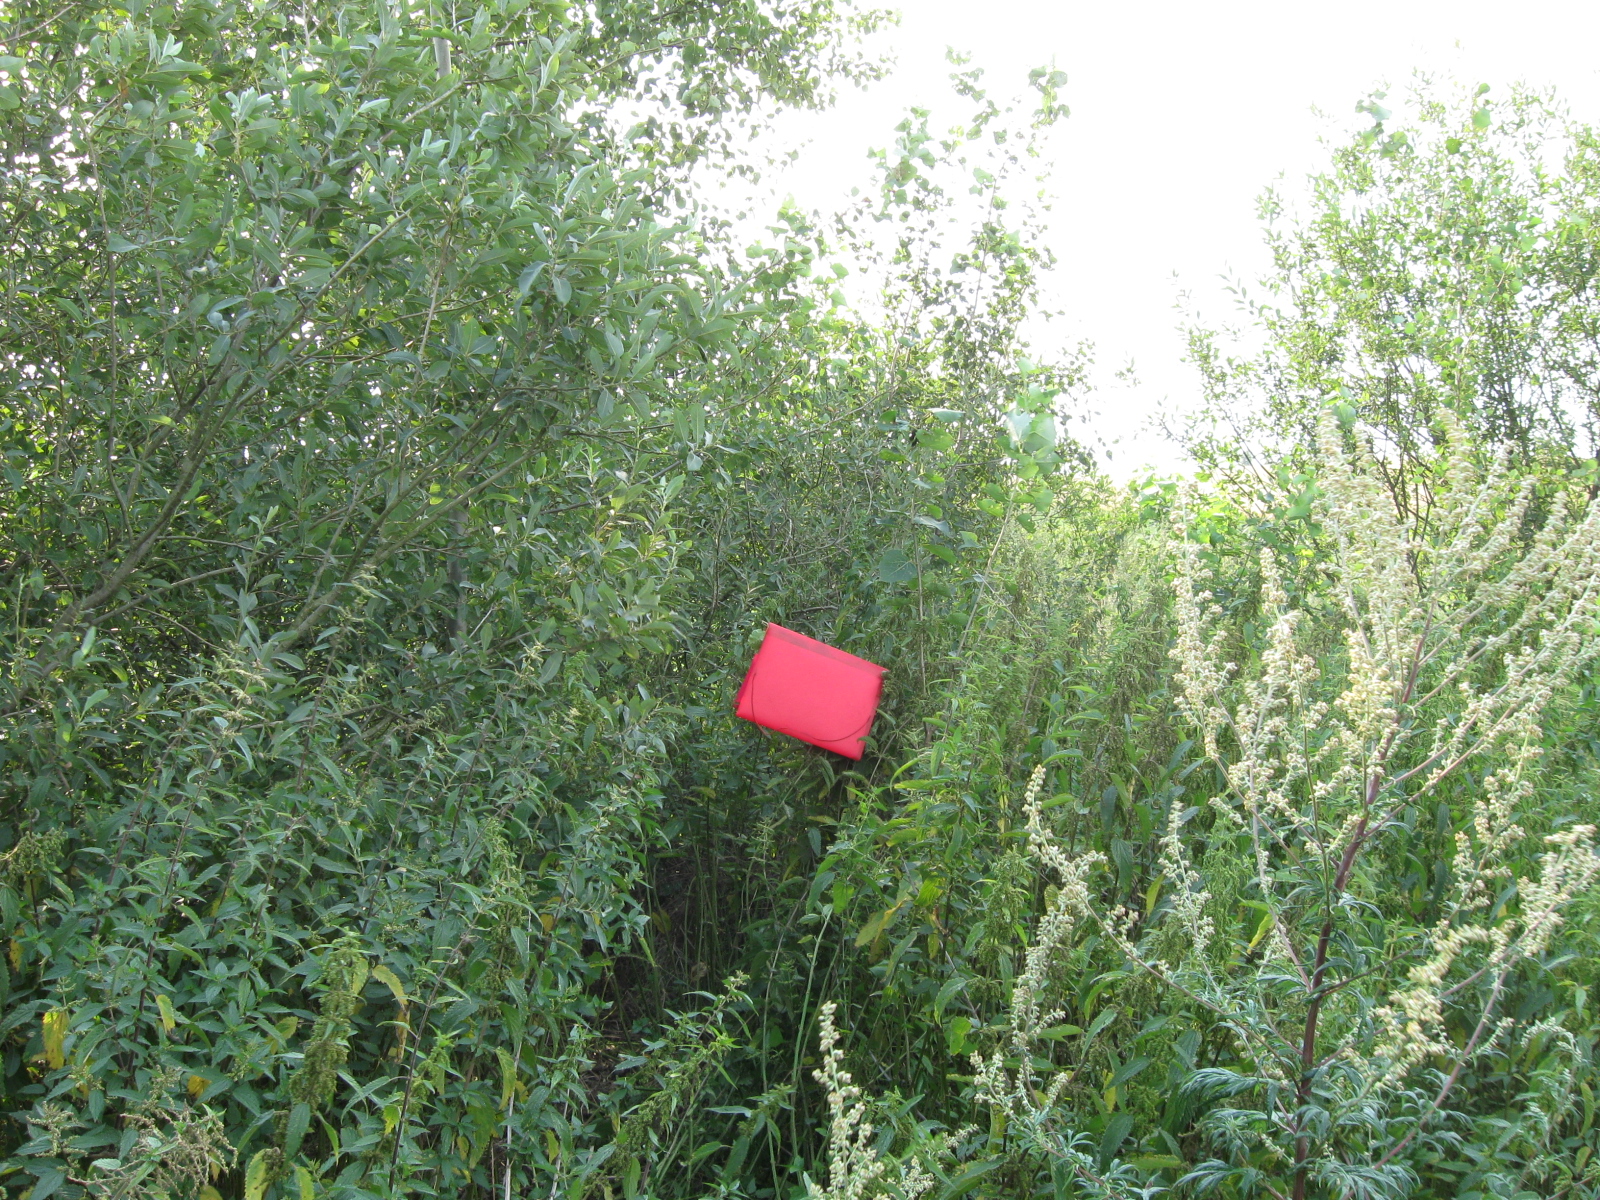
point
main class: Woodland
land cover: Broadleaved woodland
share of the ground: 50 - 75 %
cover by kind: broadleaved forest trees 60 %, shrubs 20 %, herbaceous plants 20 %
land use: Semi-natural and natural areas not in use
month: August
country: LT
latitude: 54.5442
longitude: 23.4521
